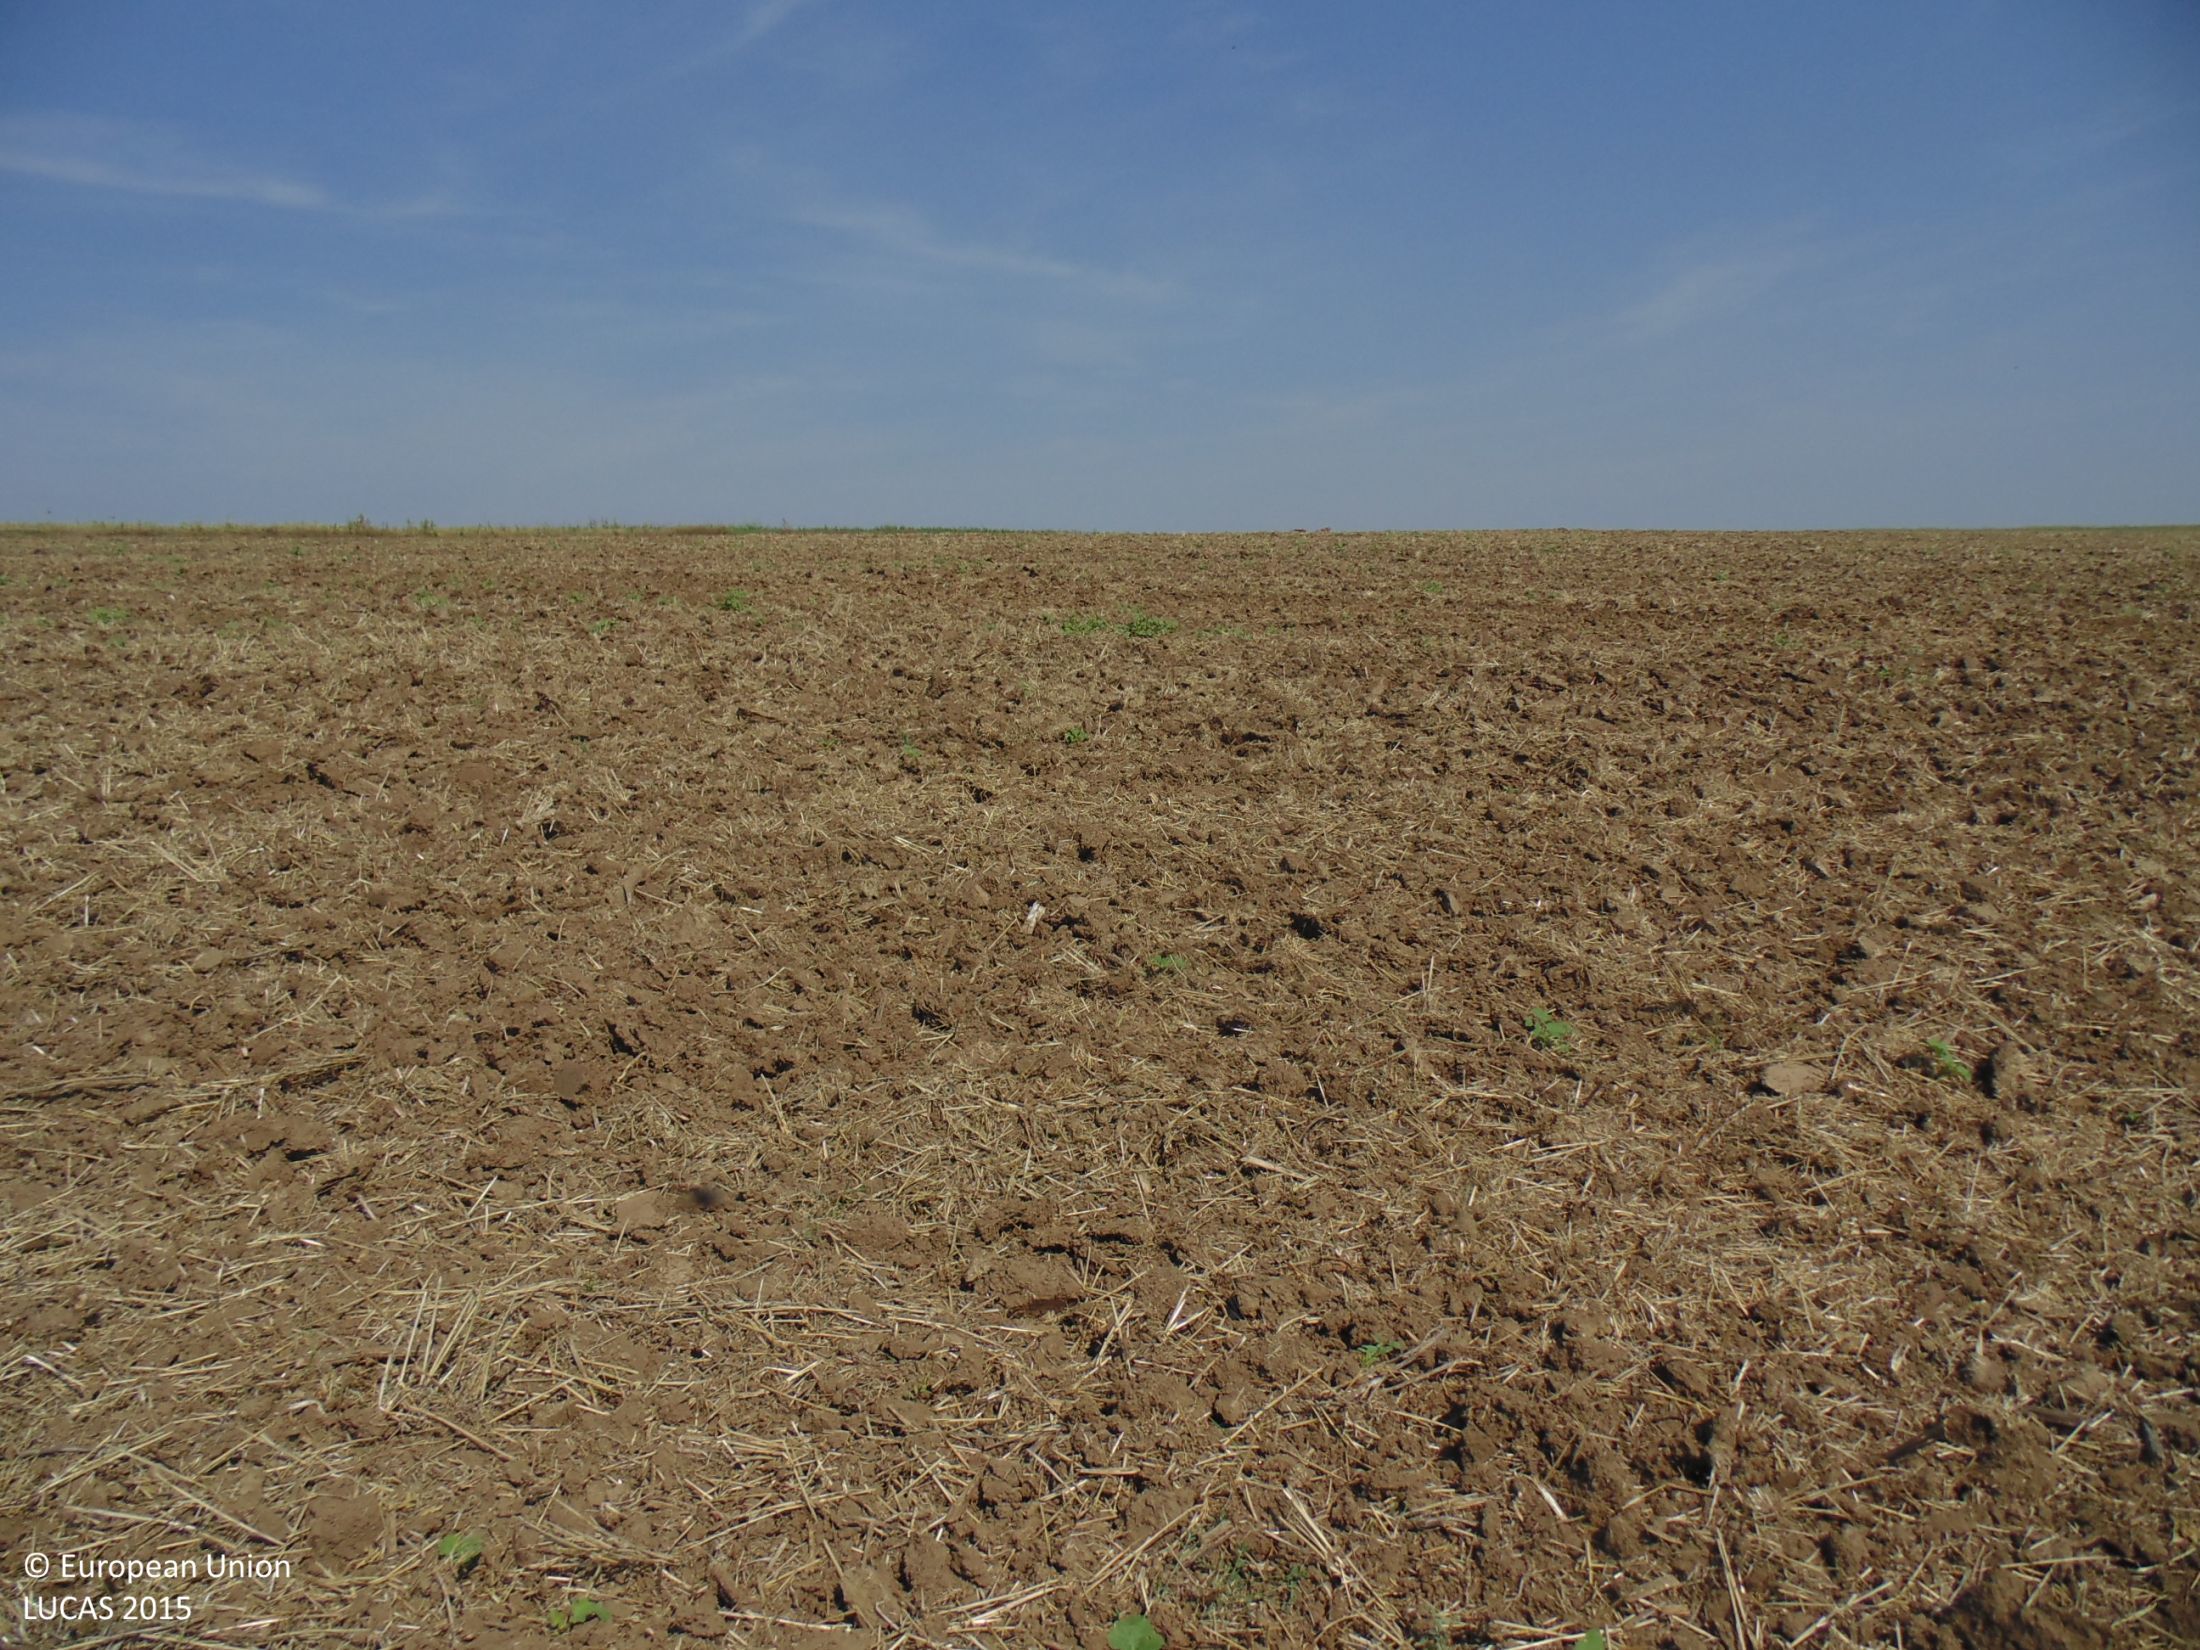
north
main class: Cropland
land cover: Common wheat
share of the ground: < 10 %
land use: Agriculture (excluding fallow land and kitchen gardens)
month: September
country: BG
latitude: 43.7631
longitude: 27.0015
